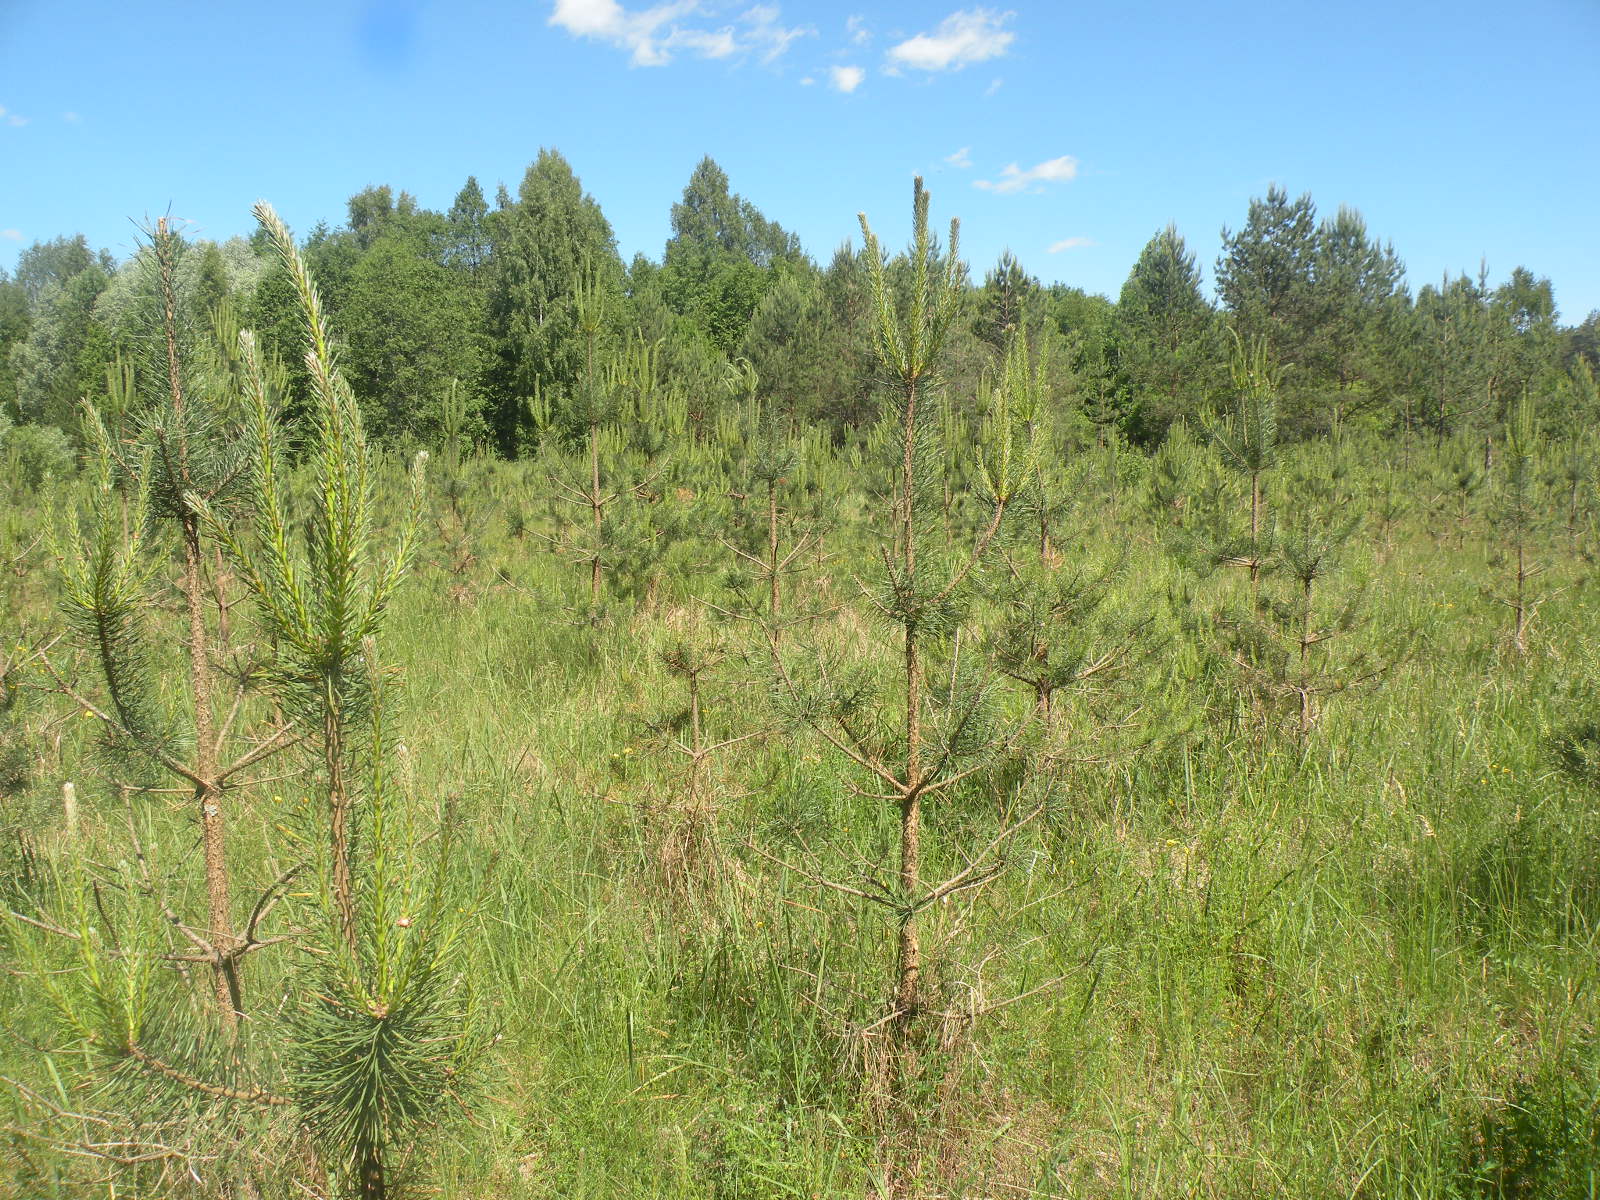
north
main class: Woodland
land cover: Pine dominated coniferous woodland
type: hemiboreal forest and nemoral coniferous forest and mixed broadleaved-coniferous forest
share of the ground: 25 - 50 %
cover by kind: herbaceous plants 55 %, coniferous forest trees 30 %, shrubs 10 %, broadleaved forest trees 5 %
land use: Forestry
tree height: < 5 m
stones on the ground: < 10 %
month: June
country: LV
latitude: 55.8866
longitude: 26.7372
